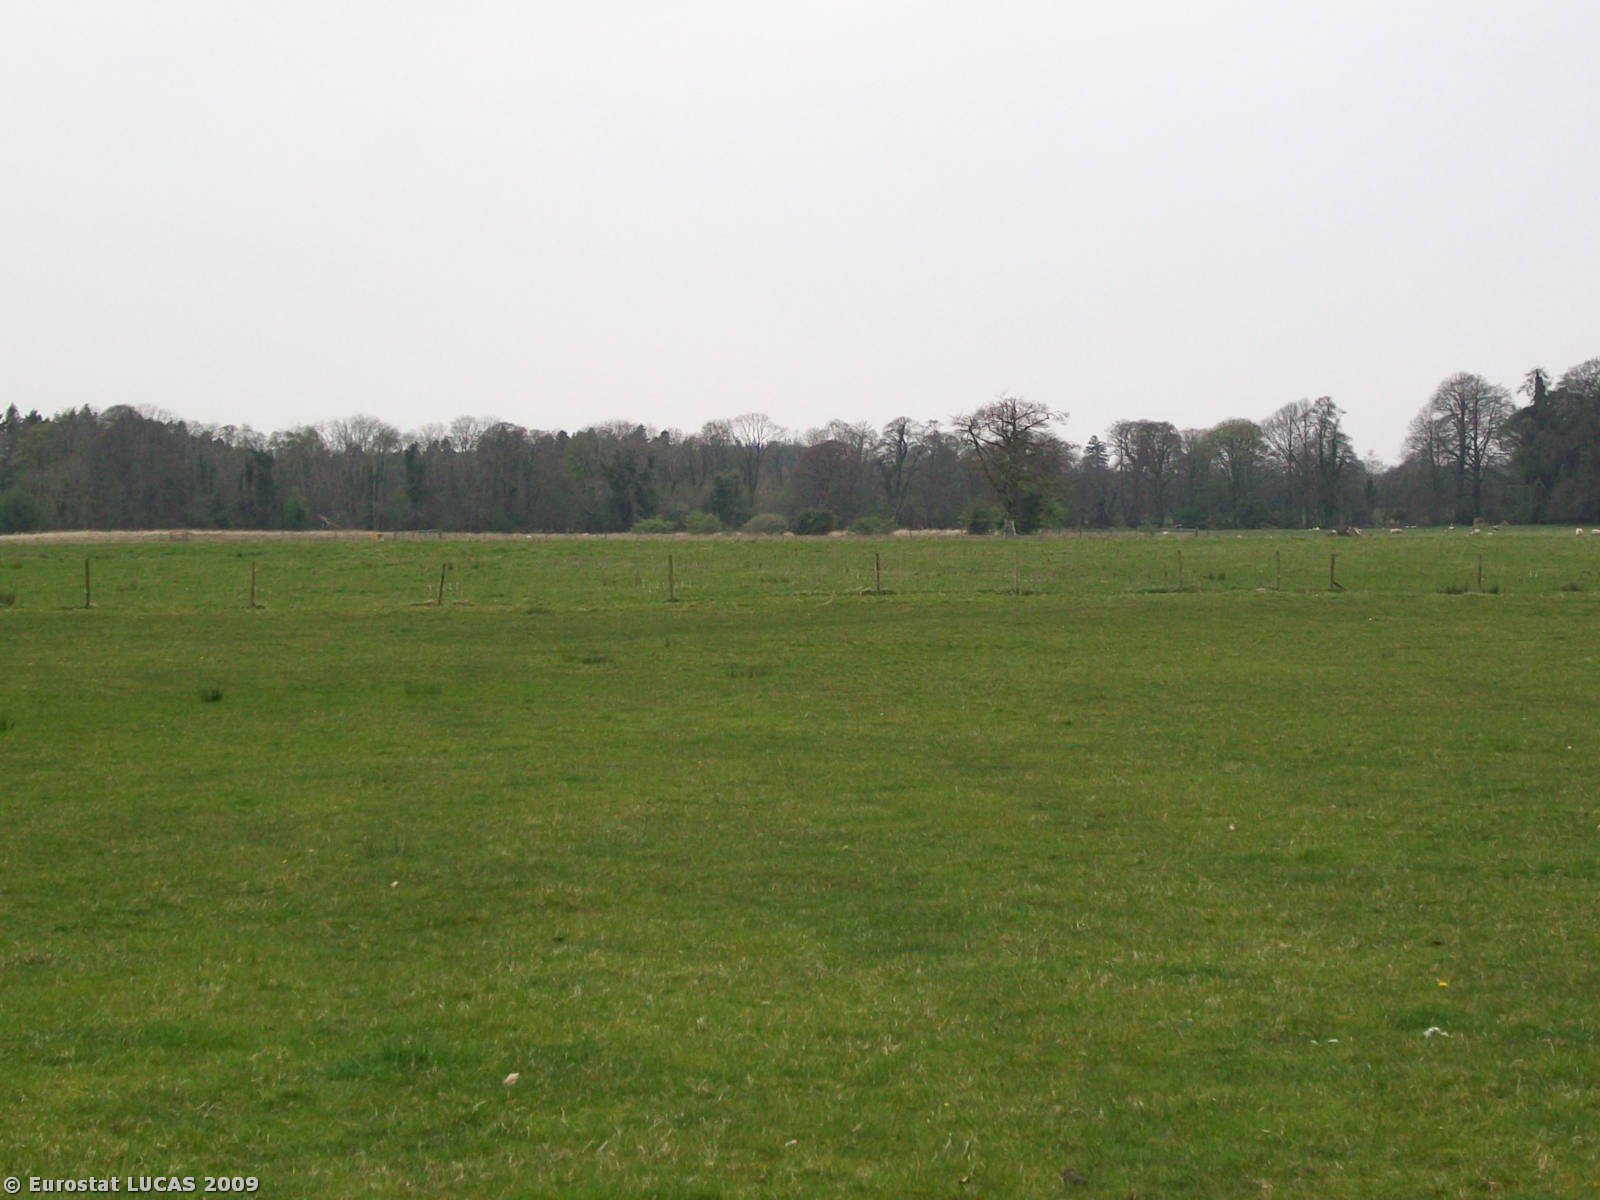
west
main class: Grassland
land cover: Grassland without tree/shrub cover
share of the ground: > 75 %
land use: Agriculture (excluding fallow land and kitchen gardens)
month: April
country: IE
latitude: 53.6185
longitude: -8.1554
